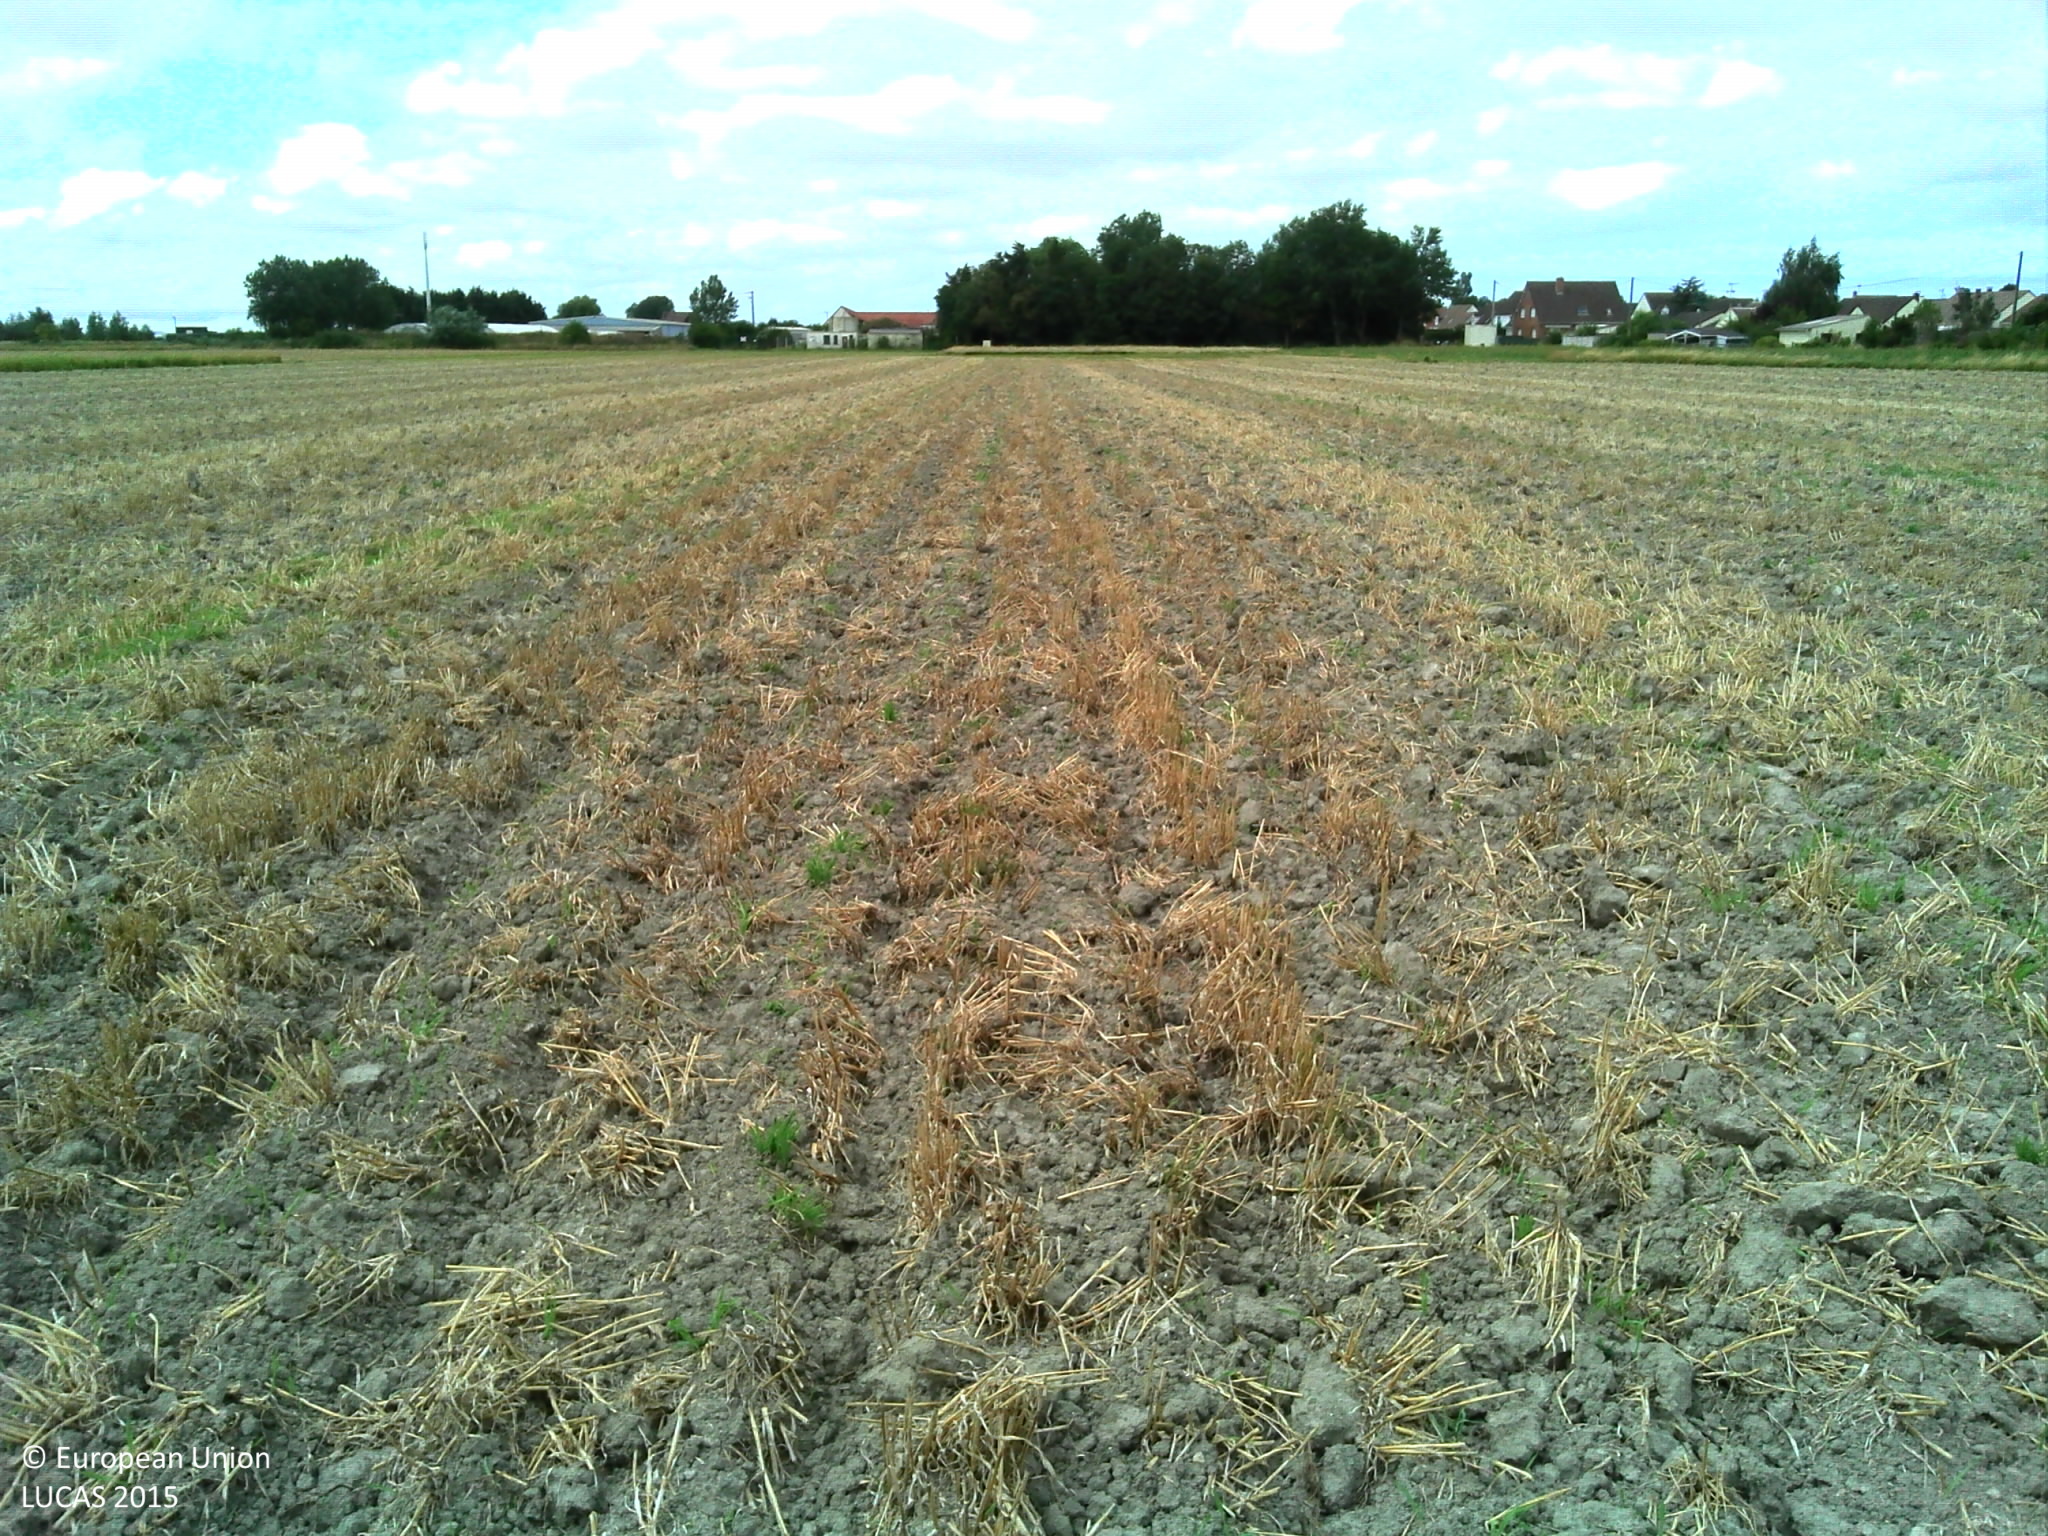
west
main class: Cropland
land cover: Barley
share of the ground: 10 - 25 %
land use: Agriculture (excluding fallow land and kitchen gardens)
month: August
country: FR
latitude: 50.9726
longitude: 2.0521
